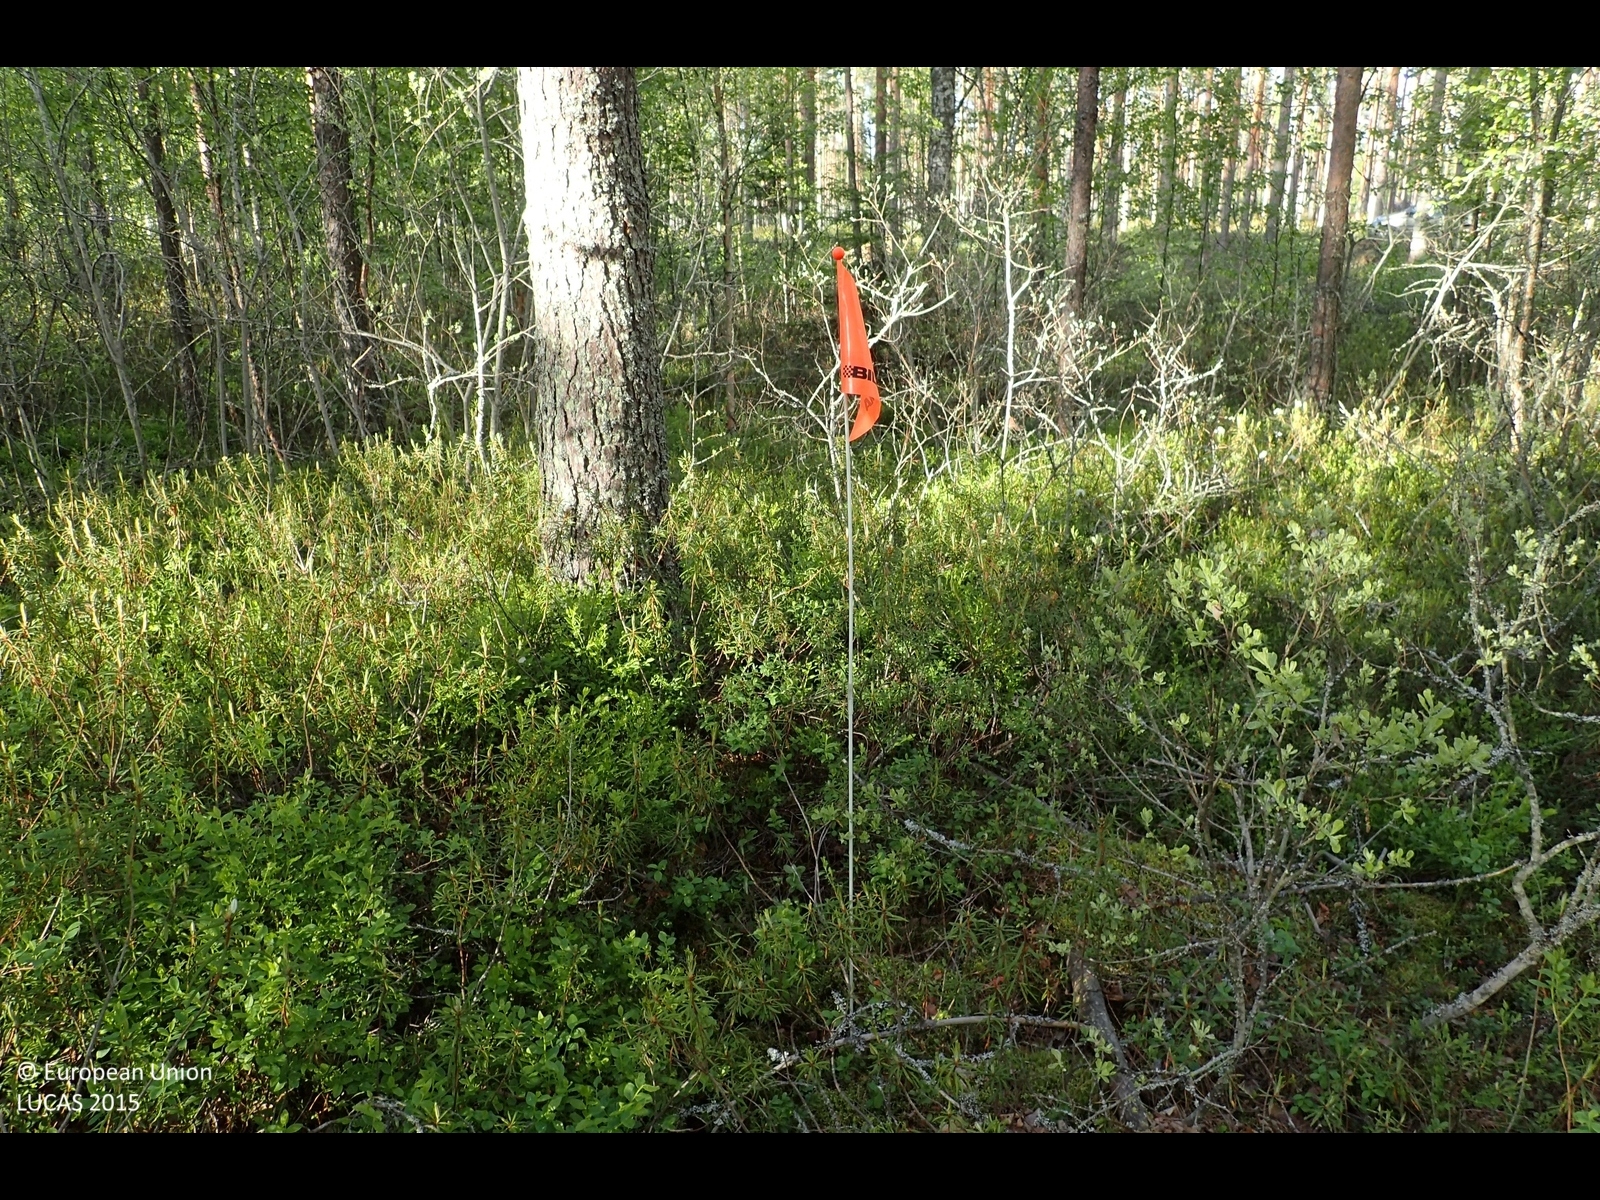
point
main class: Woodland
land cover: Pine dominated coniferous woodland
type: boreal forest
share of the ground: 25 - 50 %
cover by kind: shrubs 55 %, coniferous forest trees 40 %, broadleaved forest trees 5 %
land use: Forestry
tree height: > 5 m
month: June
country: FI
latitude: 62.4398
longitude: 23.1035
